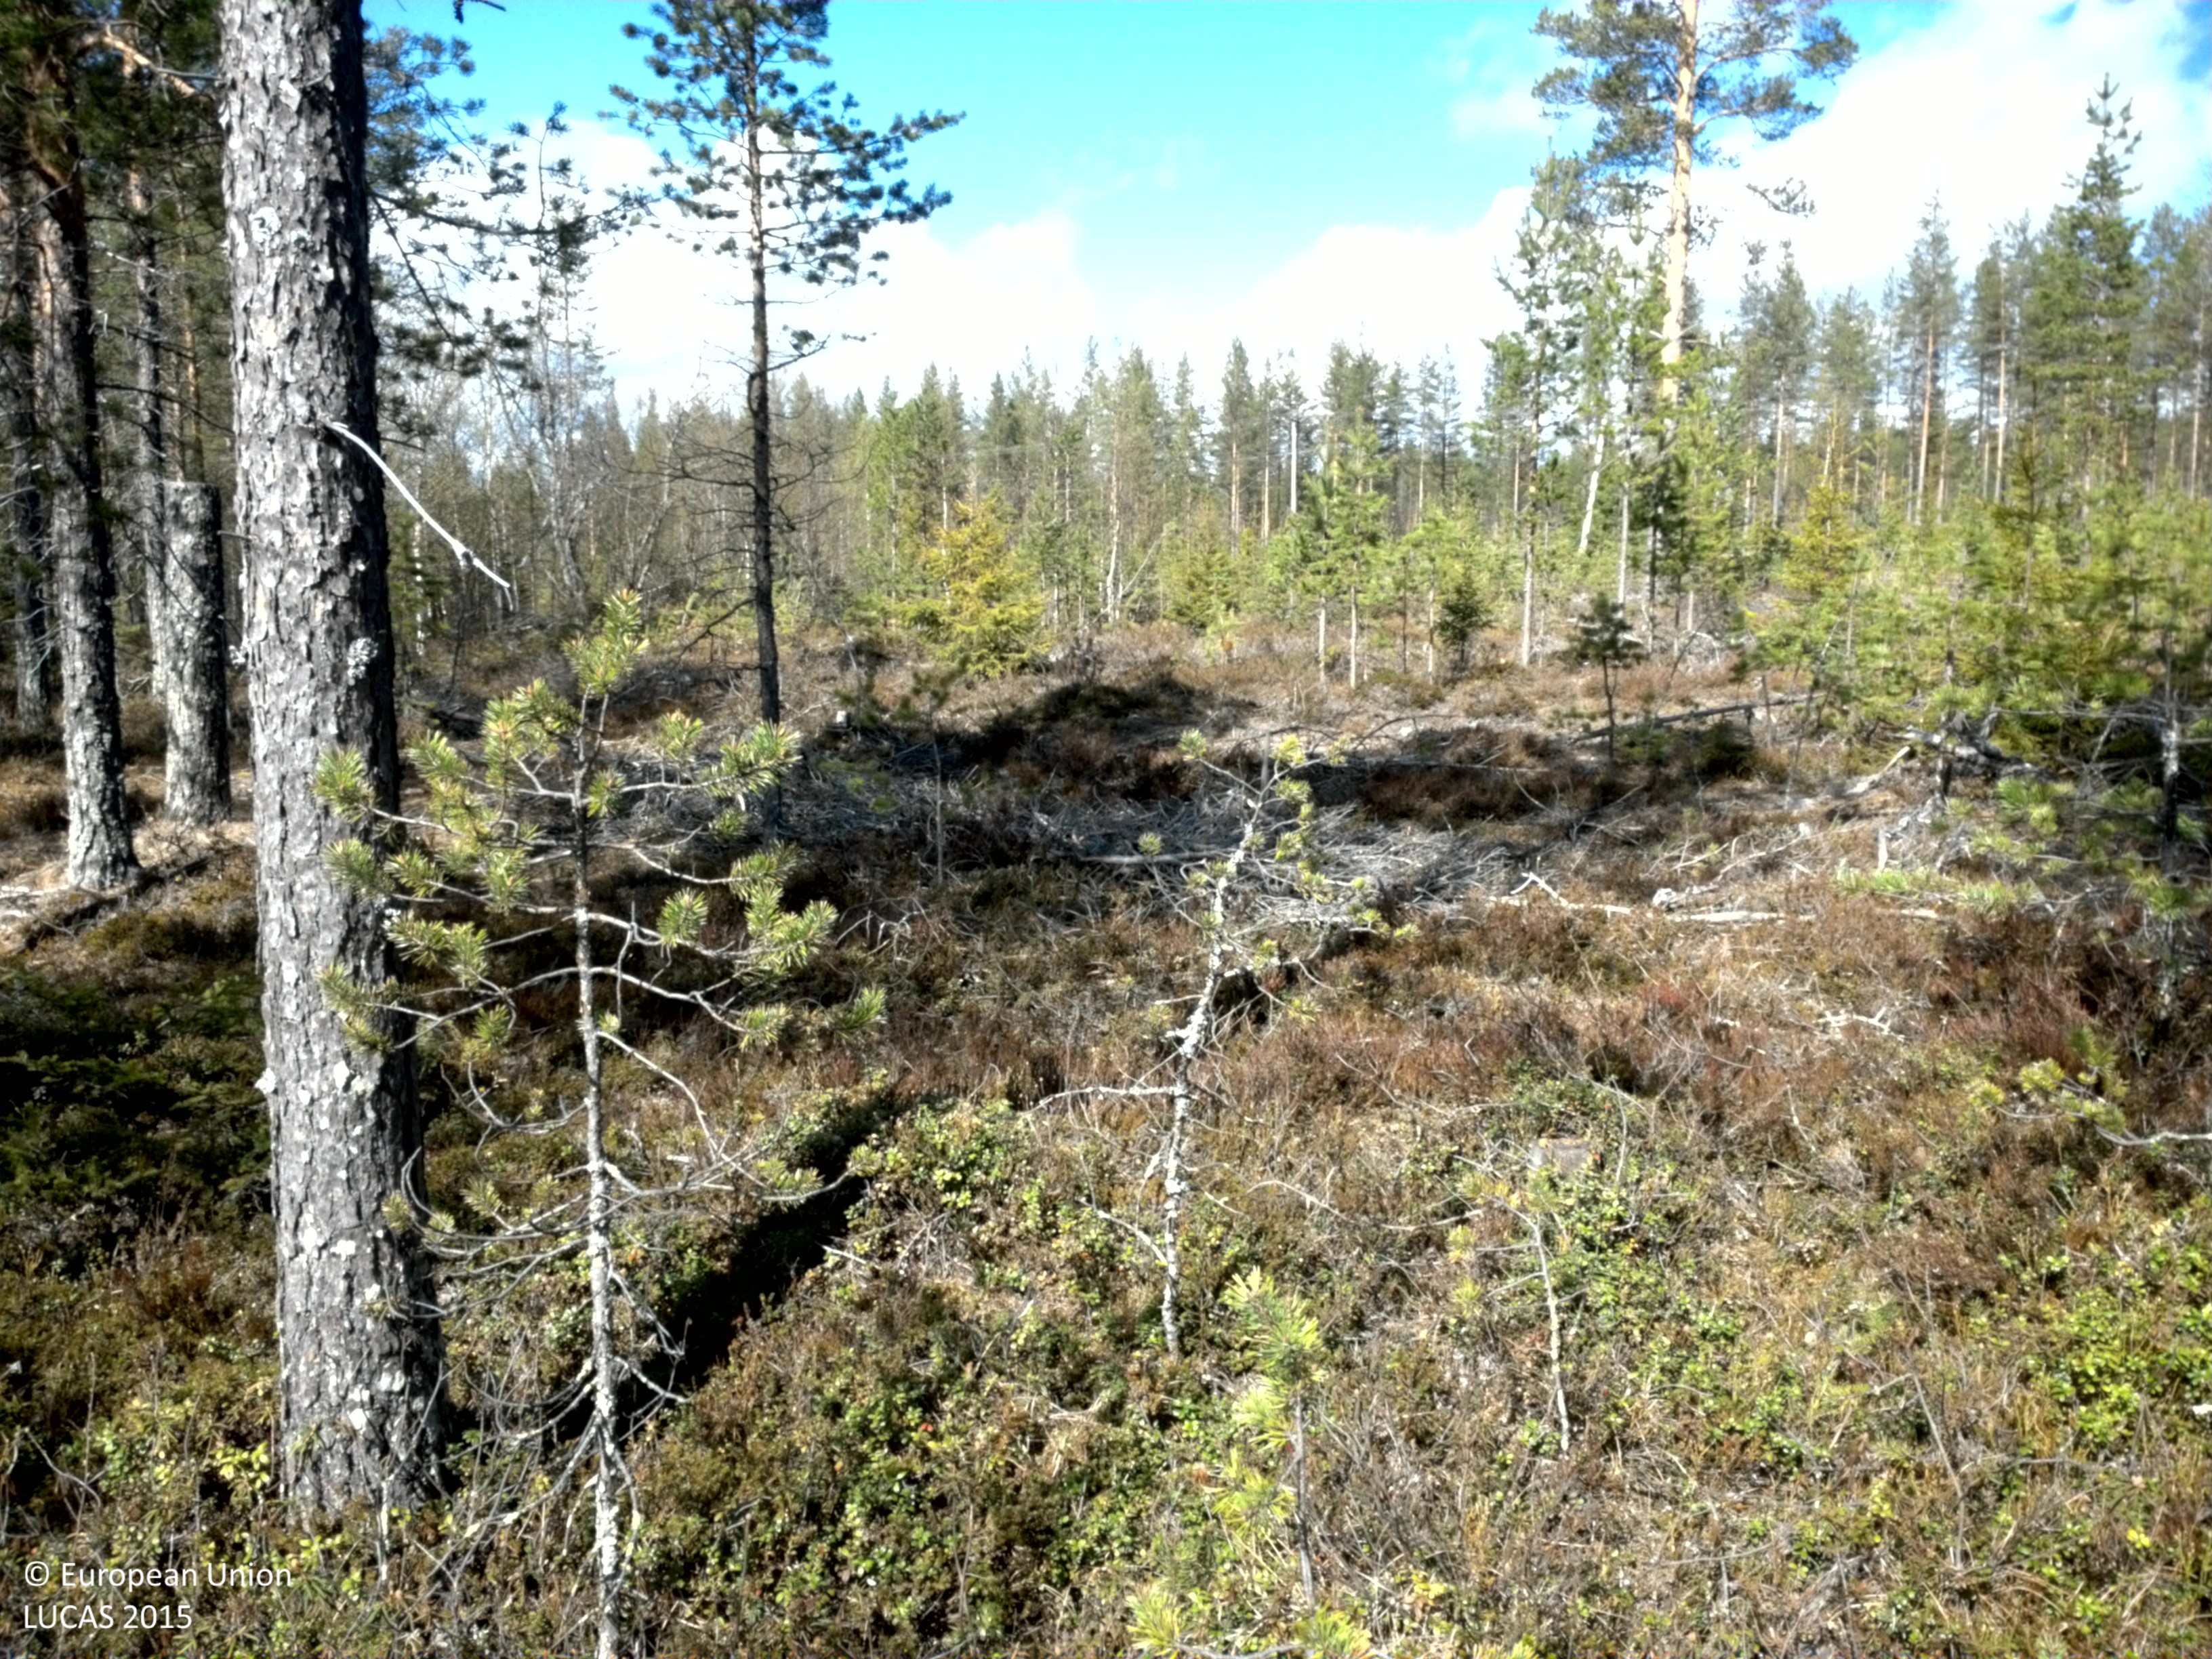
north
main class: Woodland
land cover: Pine dominated coniferous woodland
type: boreal forest
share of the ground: 25 - 50 %
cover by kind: shrubs 55 %, coniferous forest trees 45 %
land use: Forestry
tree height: > 5 m
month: May
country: SE
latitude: 66.1056
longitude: 23.1938
